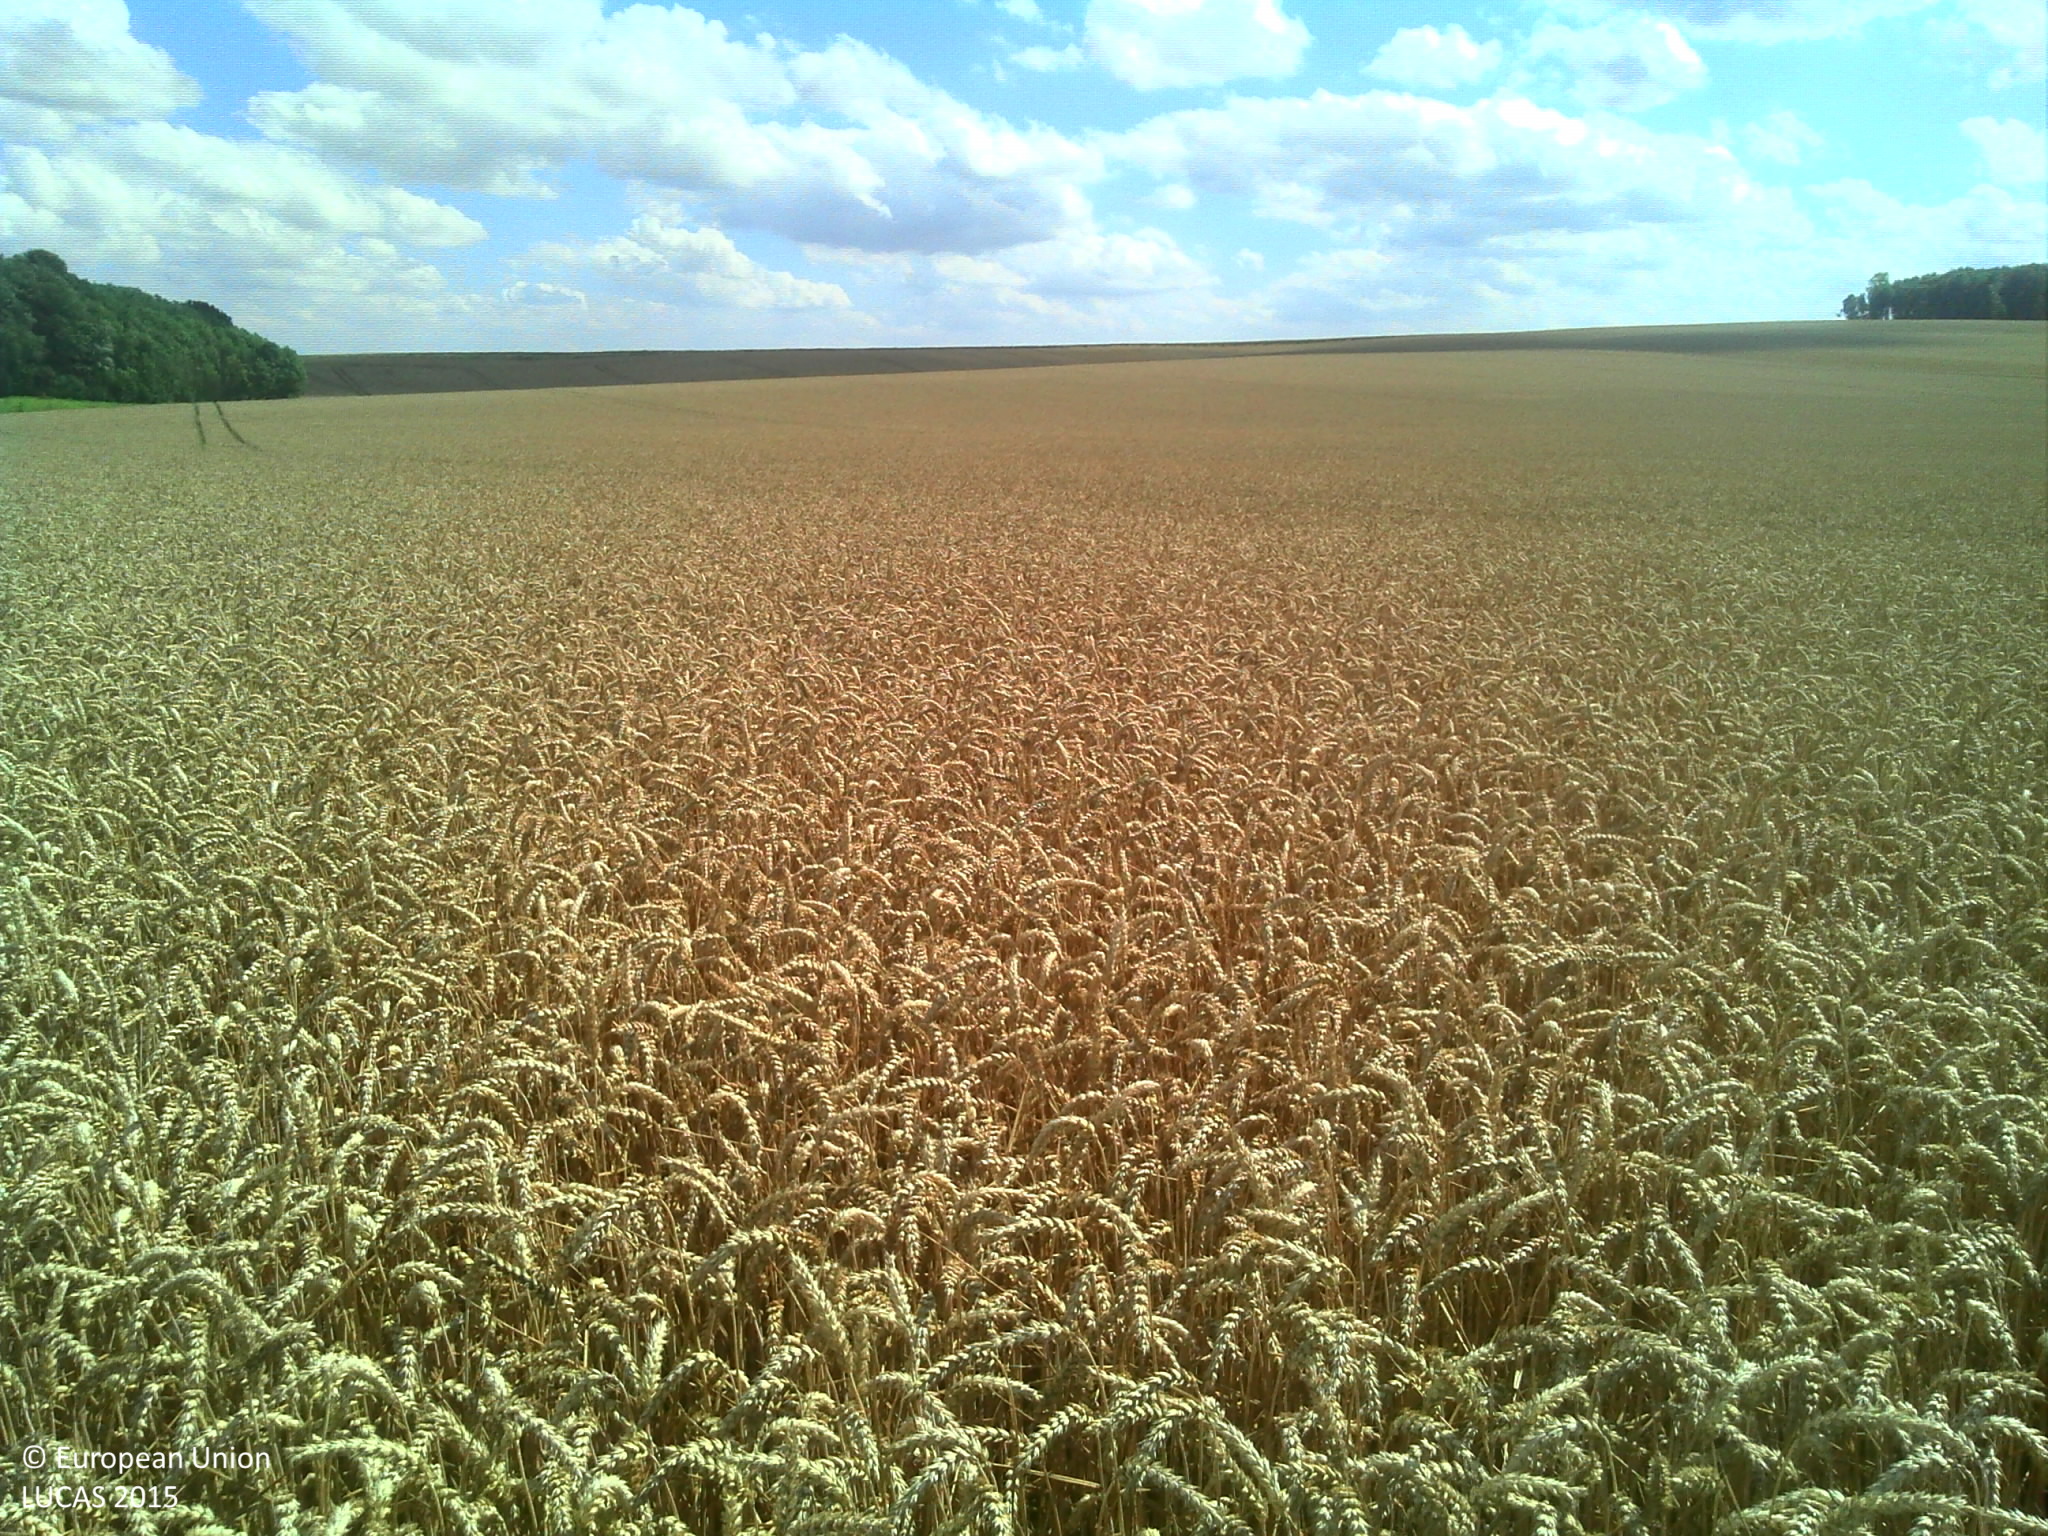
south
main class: Cropland
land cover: Common wheat
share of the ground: > 75 %
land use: Agriculture (excluding fallow land and kitchen gardens)
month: July
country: FR
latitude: 49.7547
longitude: 3.6499
